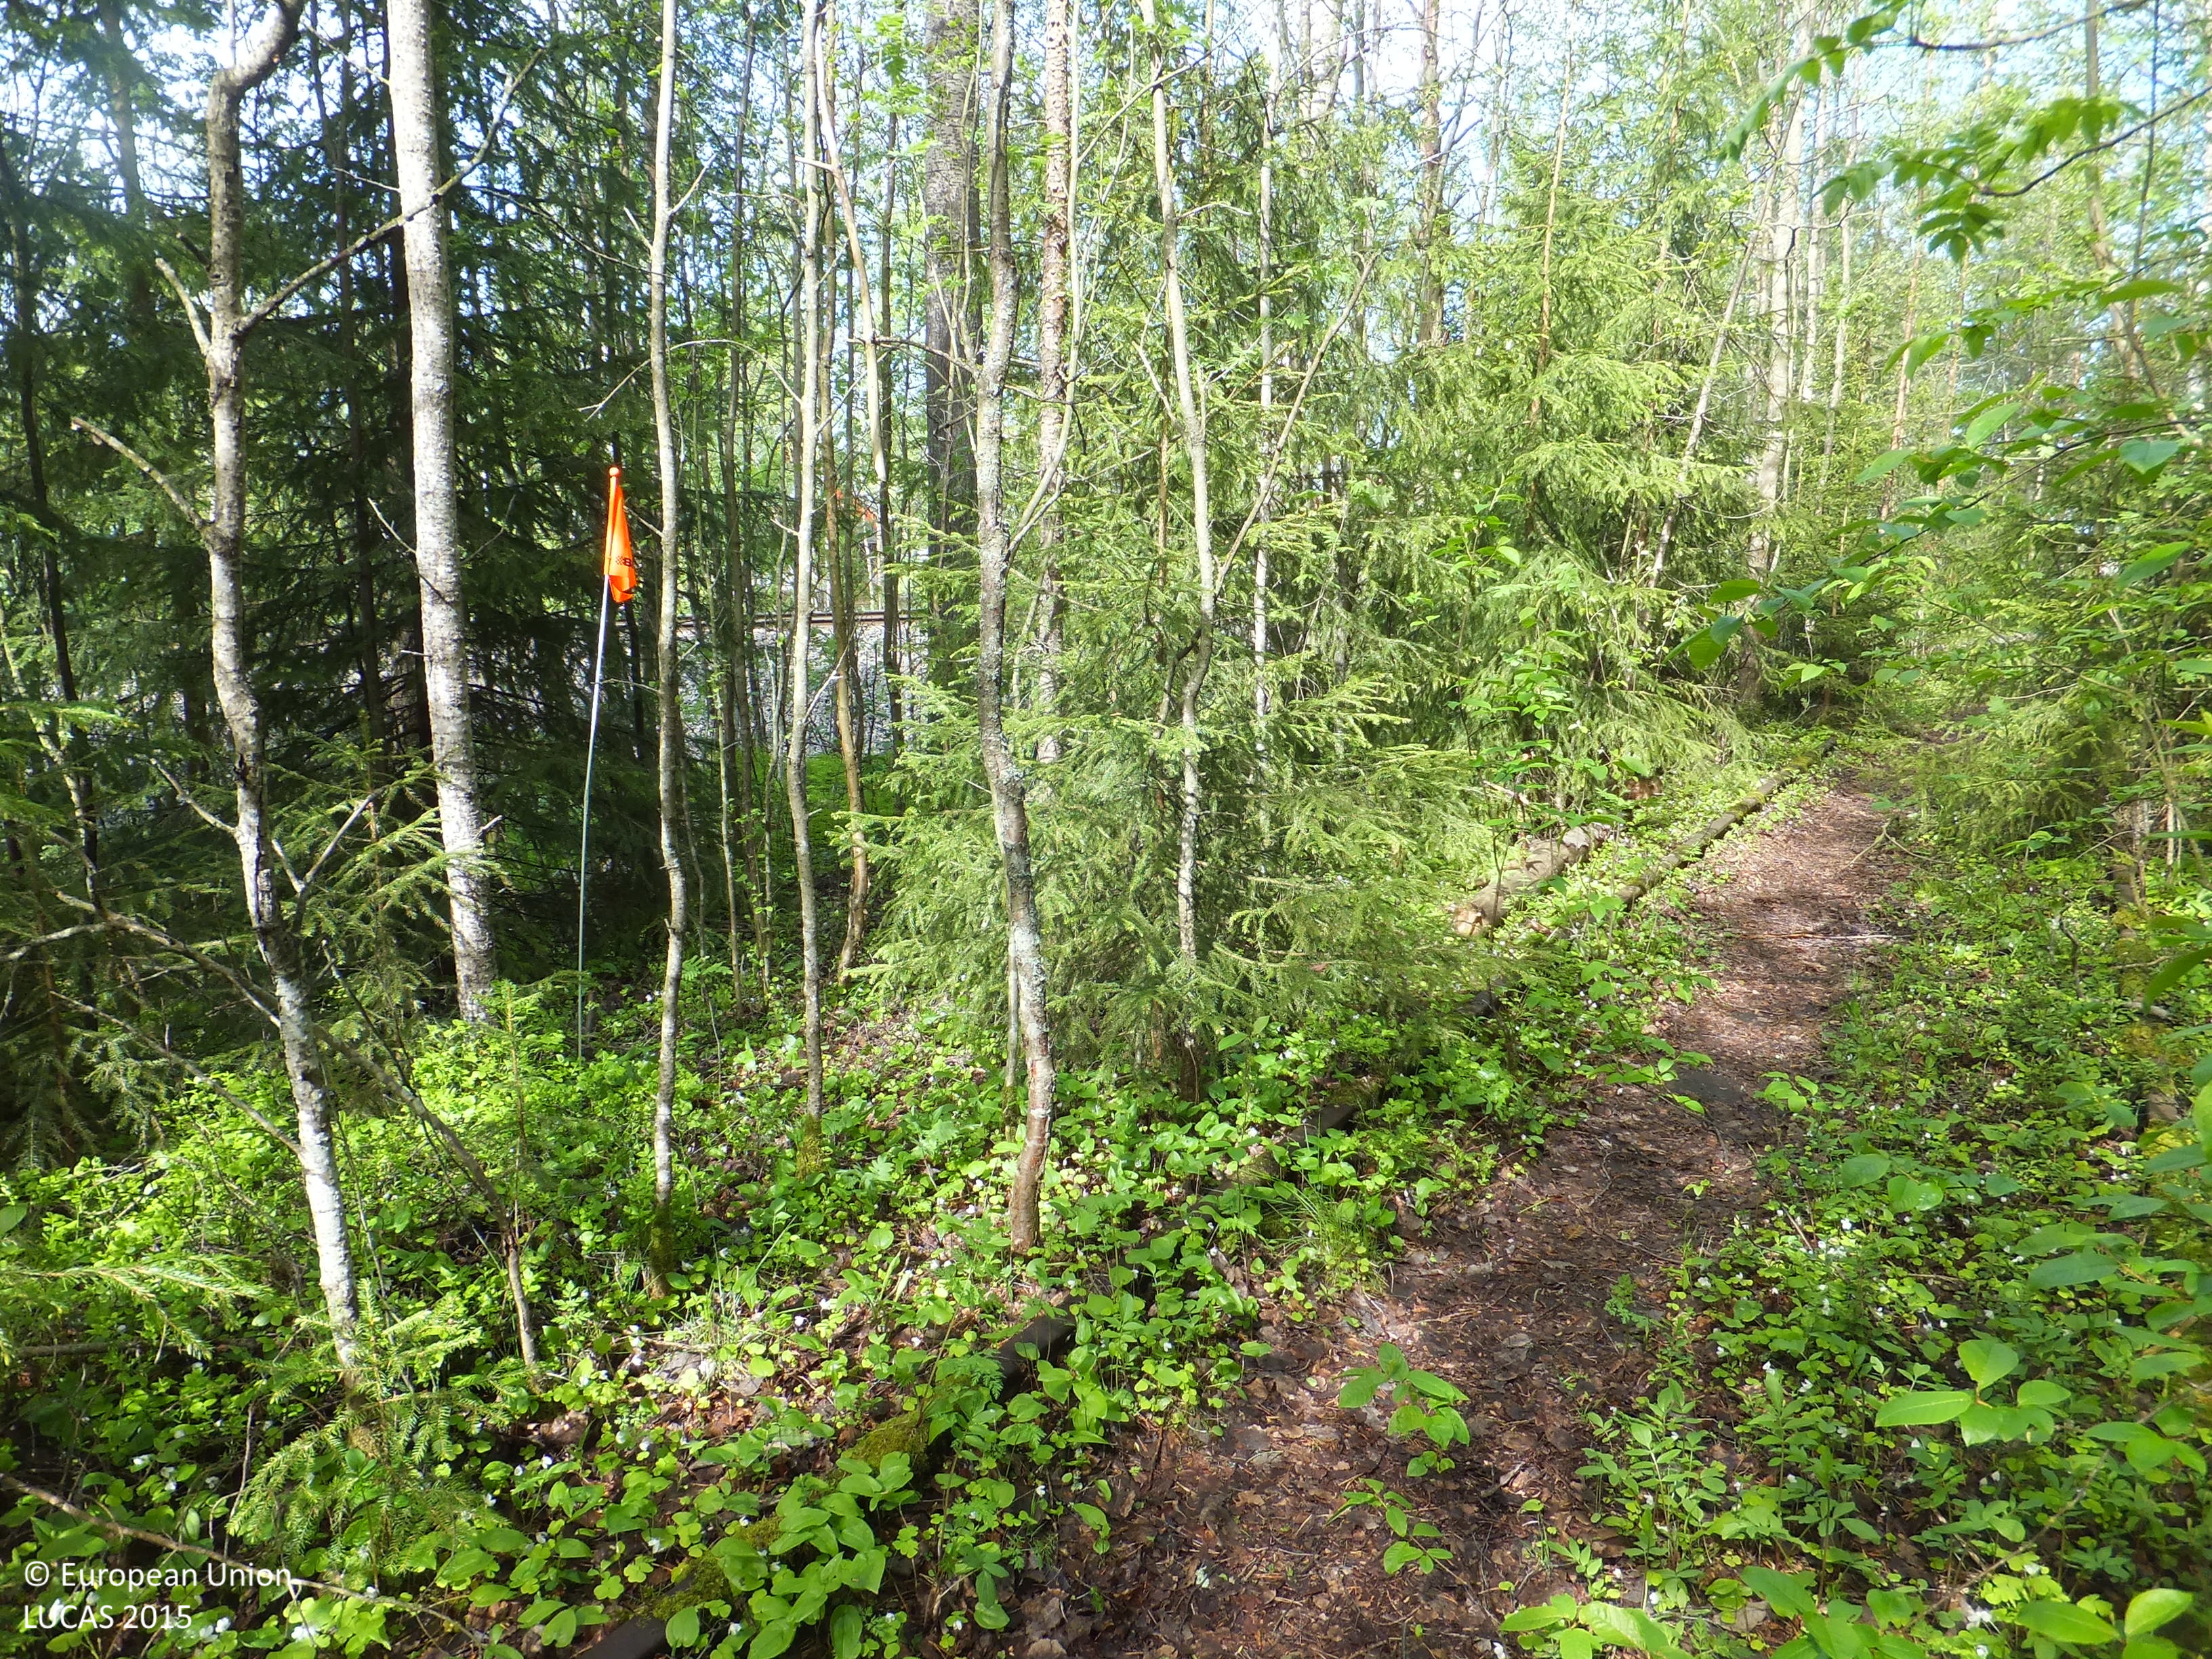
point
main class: Woodland
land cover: Other mixed woodland
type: boreal forest
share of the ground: > 75 %
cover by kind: broadleaved forest trees 70 %, coniferous forest trees 30 %
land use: Semi-natural and natural areas not in use
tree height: > 5 m
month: May
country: FI
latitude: 63.6643
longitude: 22.7165
